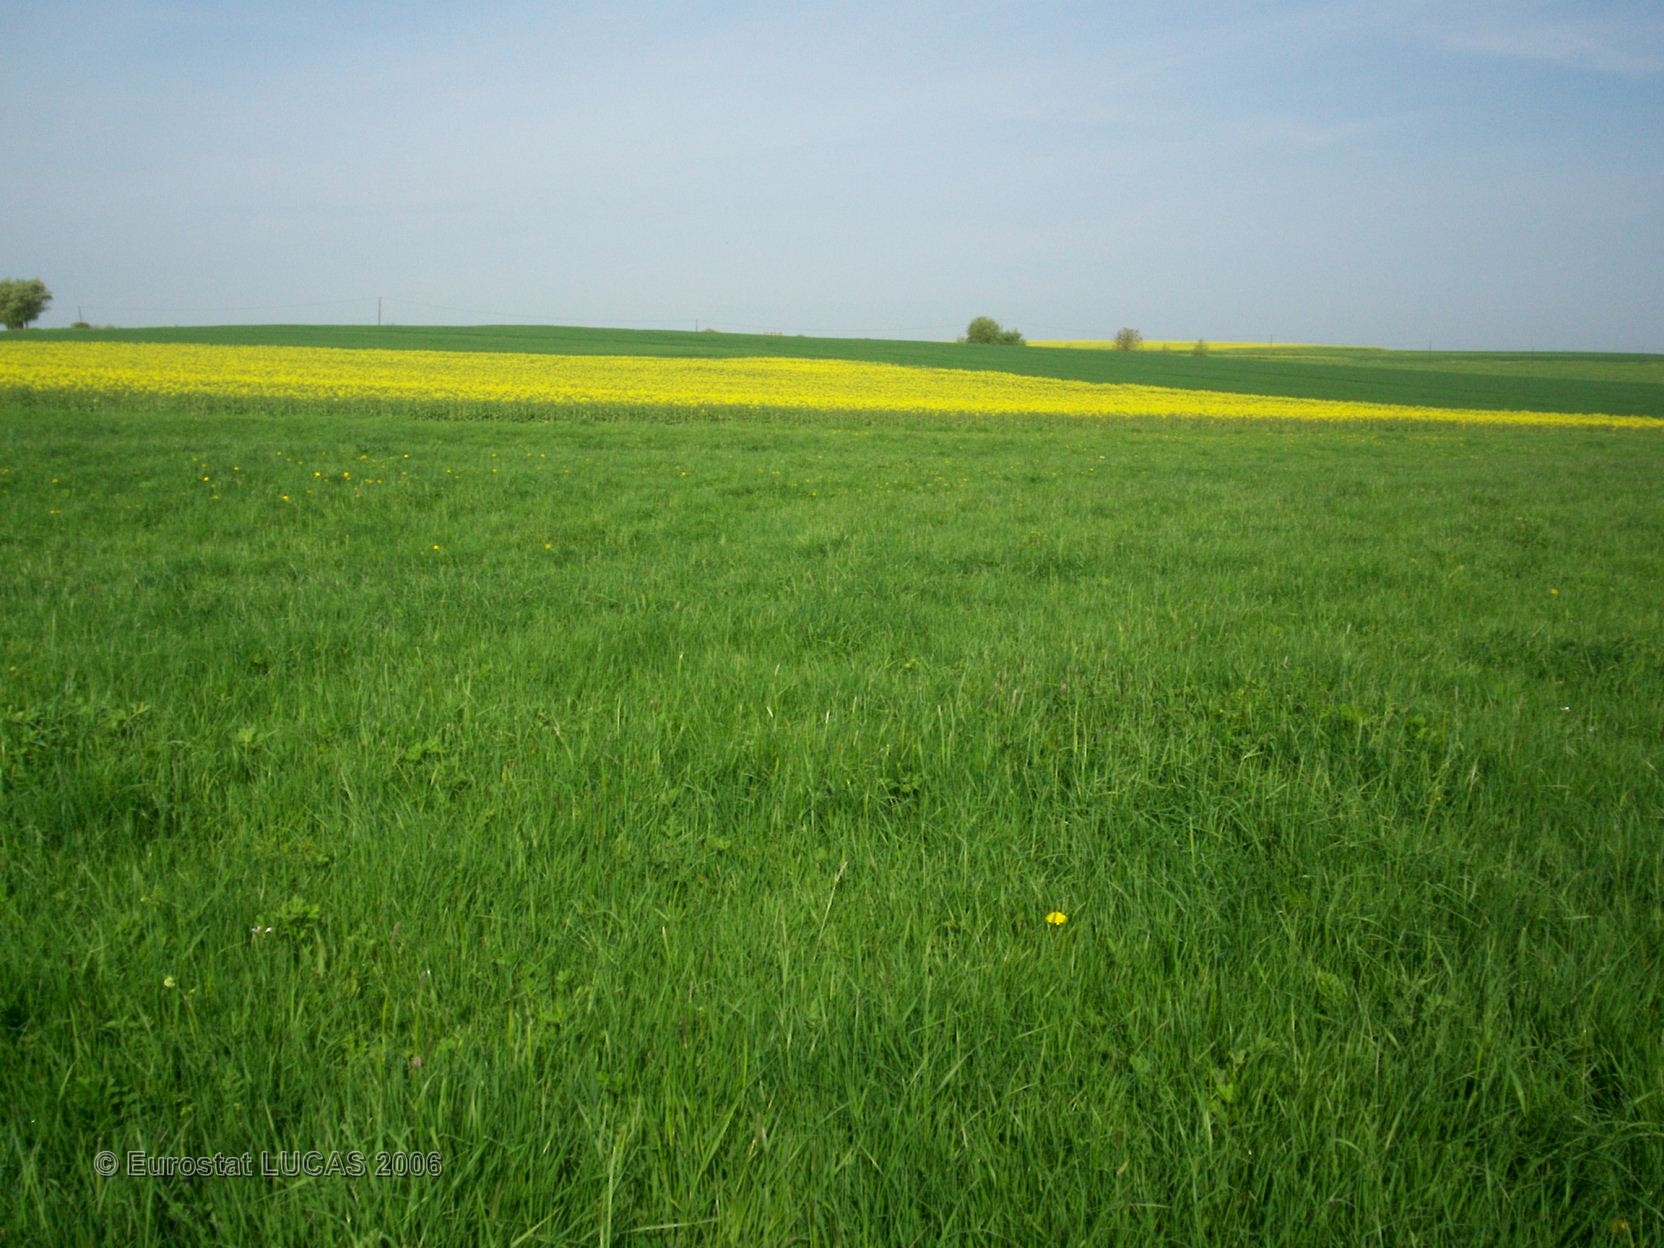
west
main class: Grassland
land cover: Grassland without tree/shrub cover
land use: Agriculture (excluding fallow land and kitchen gardens)
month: May
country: FR
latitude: 49.0867
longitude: 6.5084
